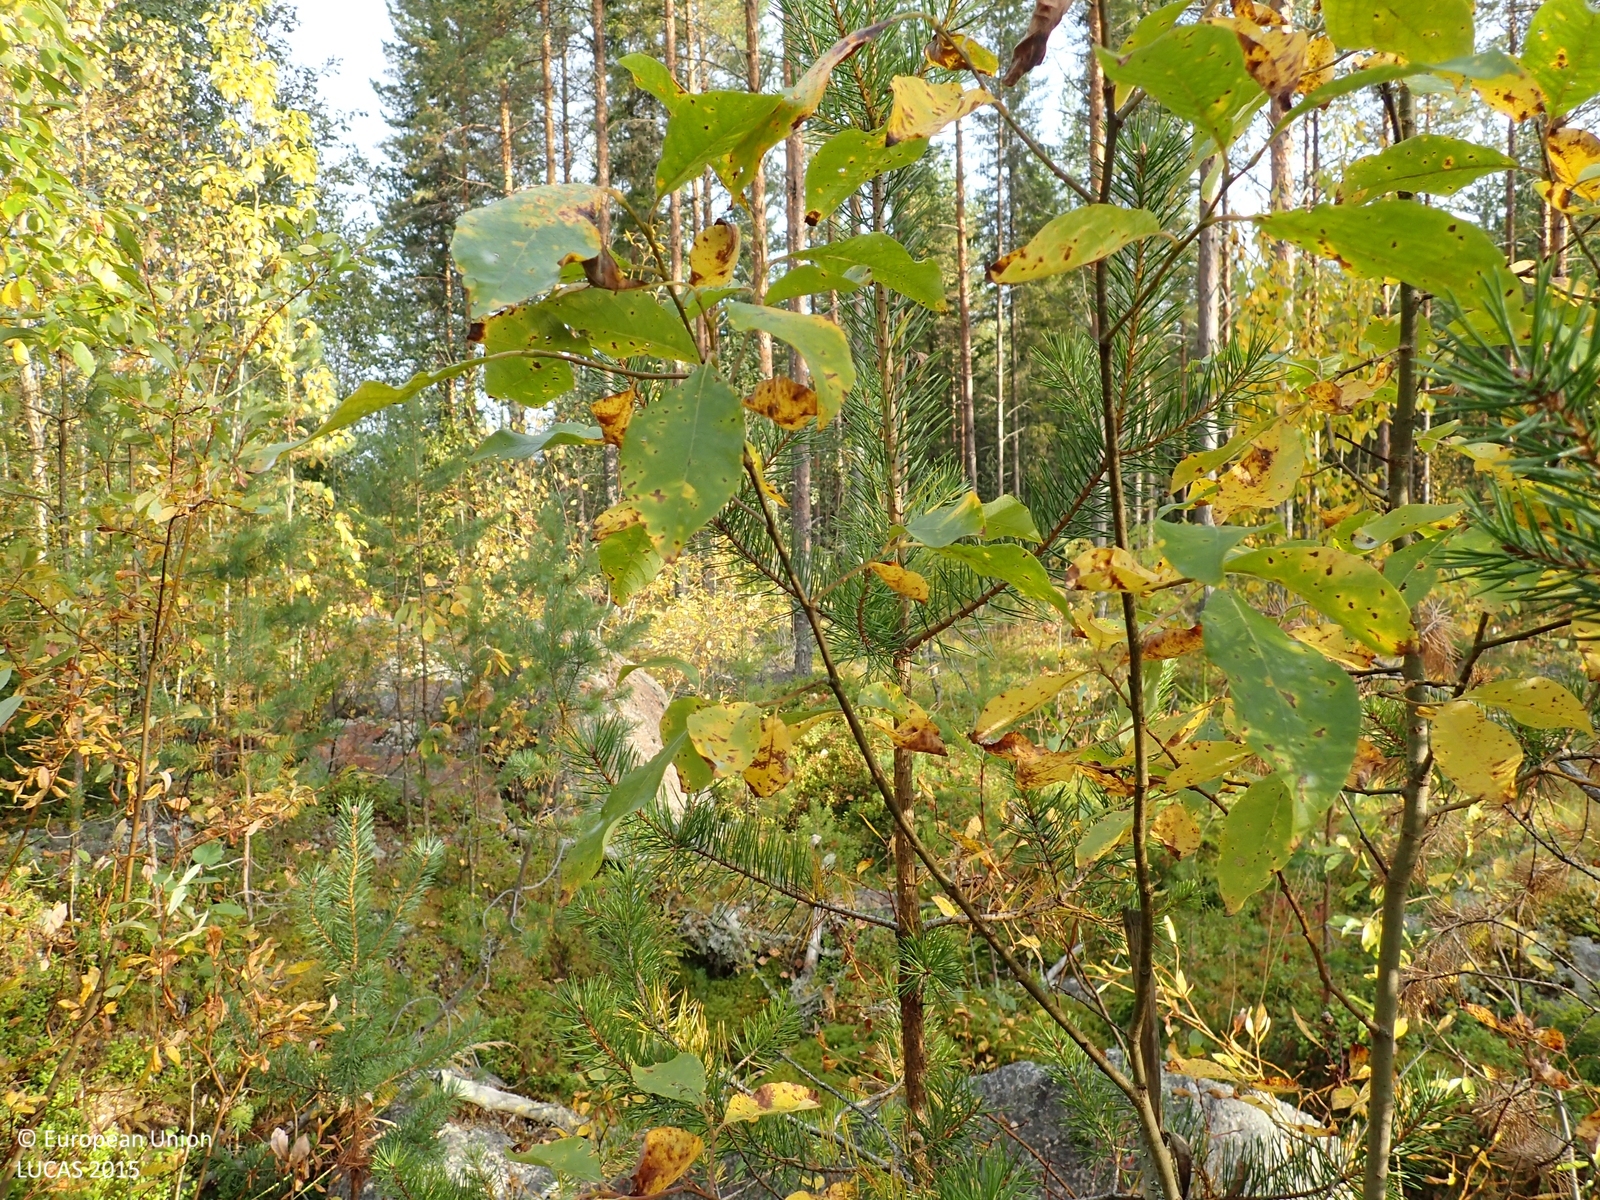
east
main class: Woodland
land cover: Pine dominated mixed woodland
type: boreal forest
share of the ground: 50 - 75 %
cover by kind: shrubs 40 %, broadleaved forest trees 35 %, coniferous forest trees 15 %, lichens and mosses 5 %, consolidated bare surface 5 %
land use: Forestry
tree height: < 5 m
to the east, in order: Pine dominated mixed woodland; Grass margins; Paved roads, cycling and walking lanes; Abandoned hedges; Other coniferous woodland; Spruce dominated mixed woodland; Grassland with sparse tree/shrub cover; Spruce dominated coniferous woodland; Spruce dominated mixed woodland
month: September
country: FI
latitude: 63.0316
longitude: 25.7464
